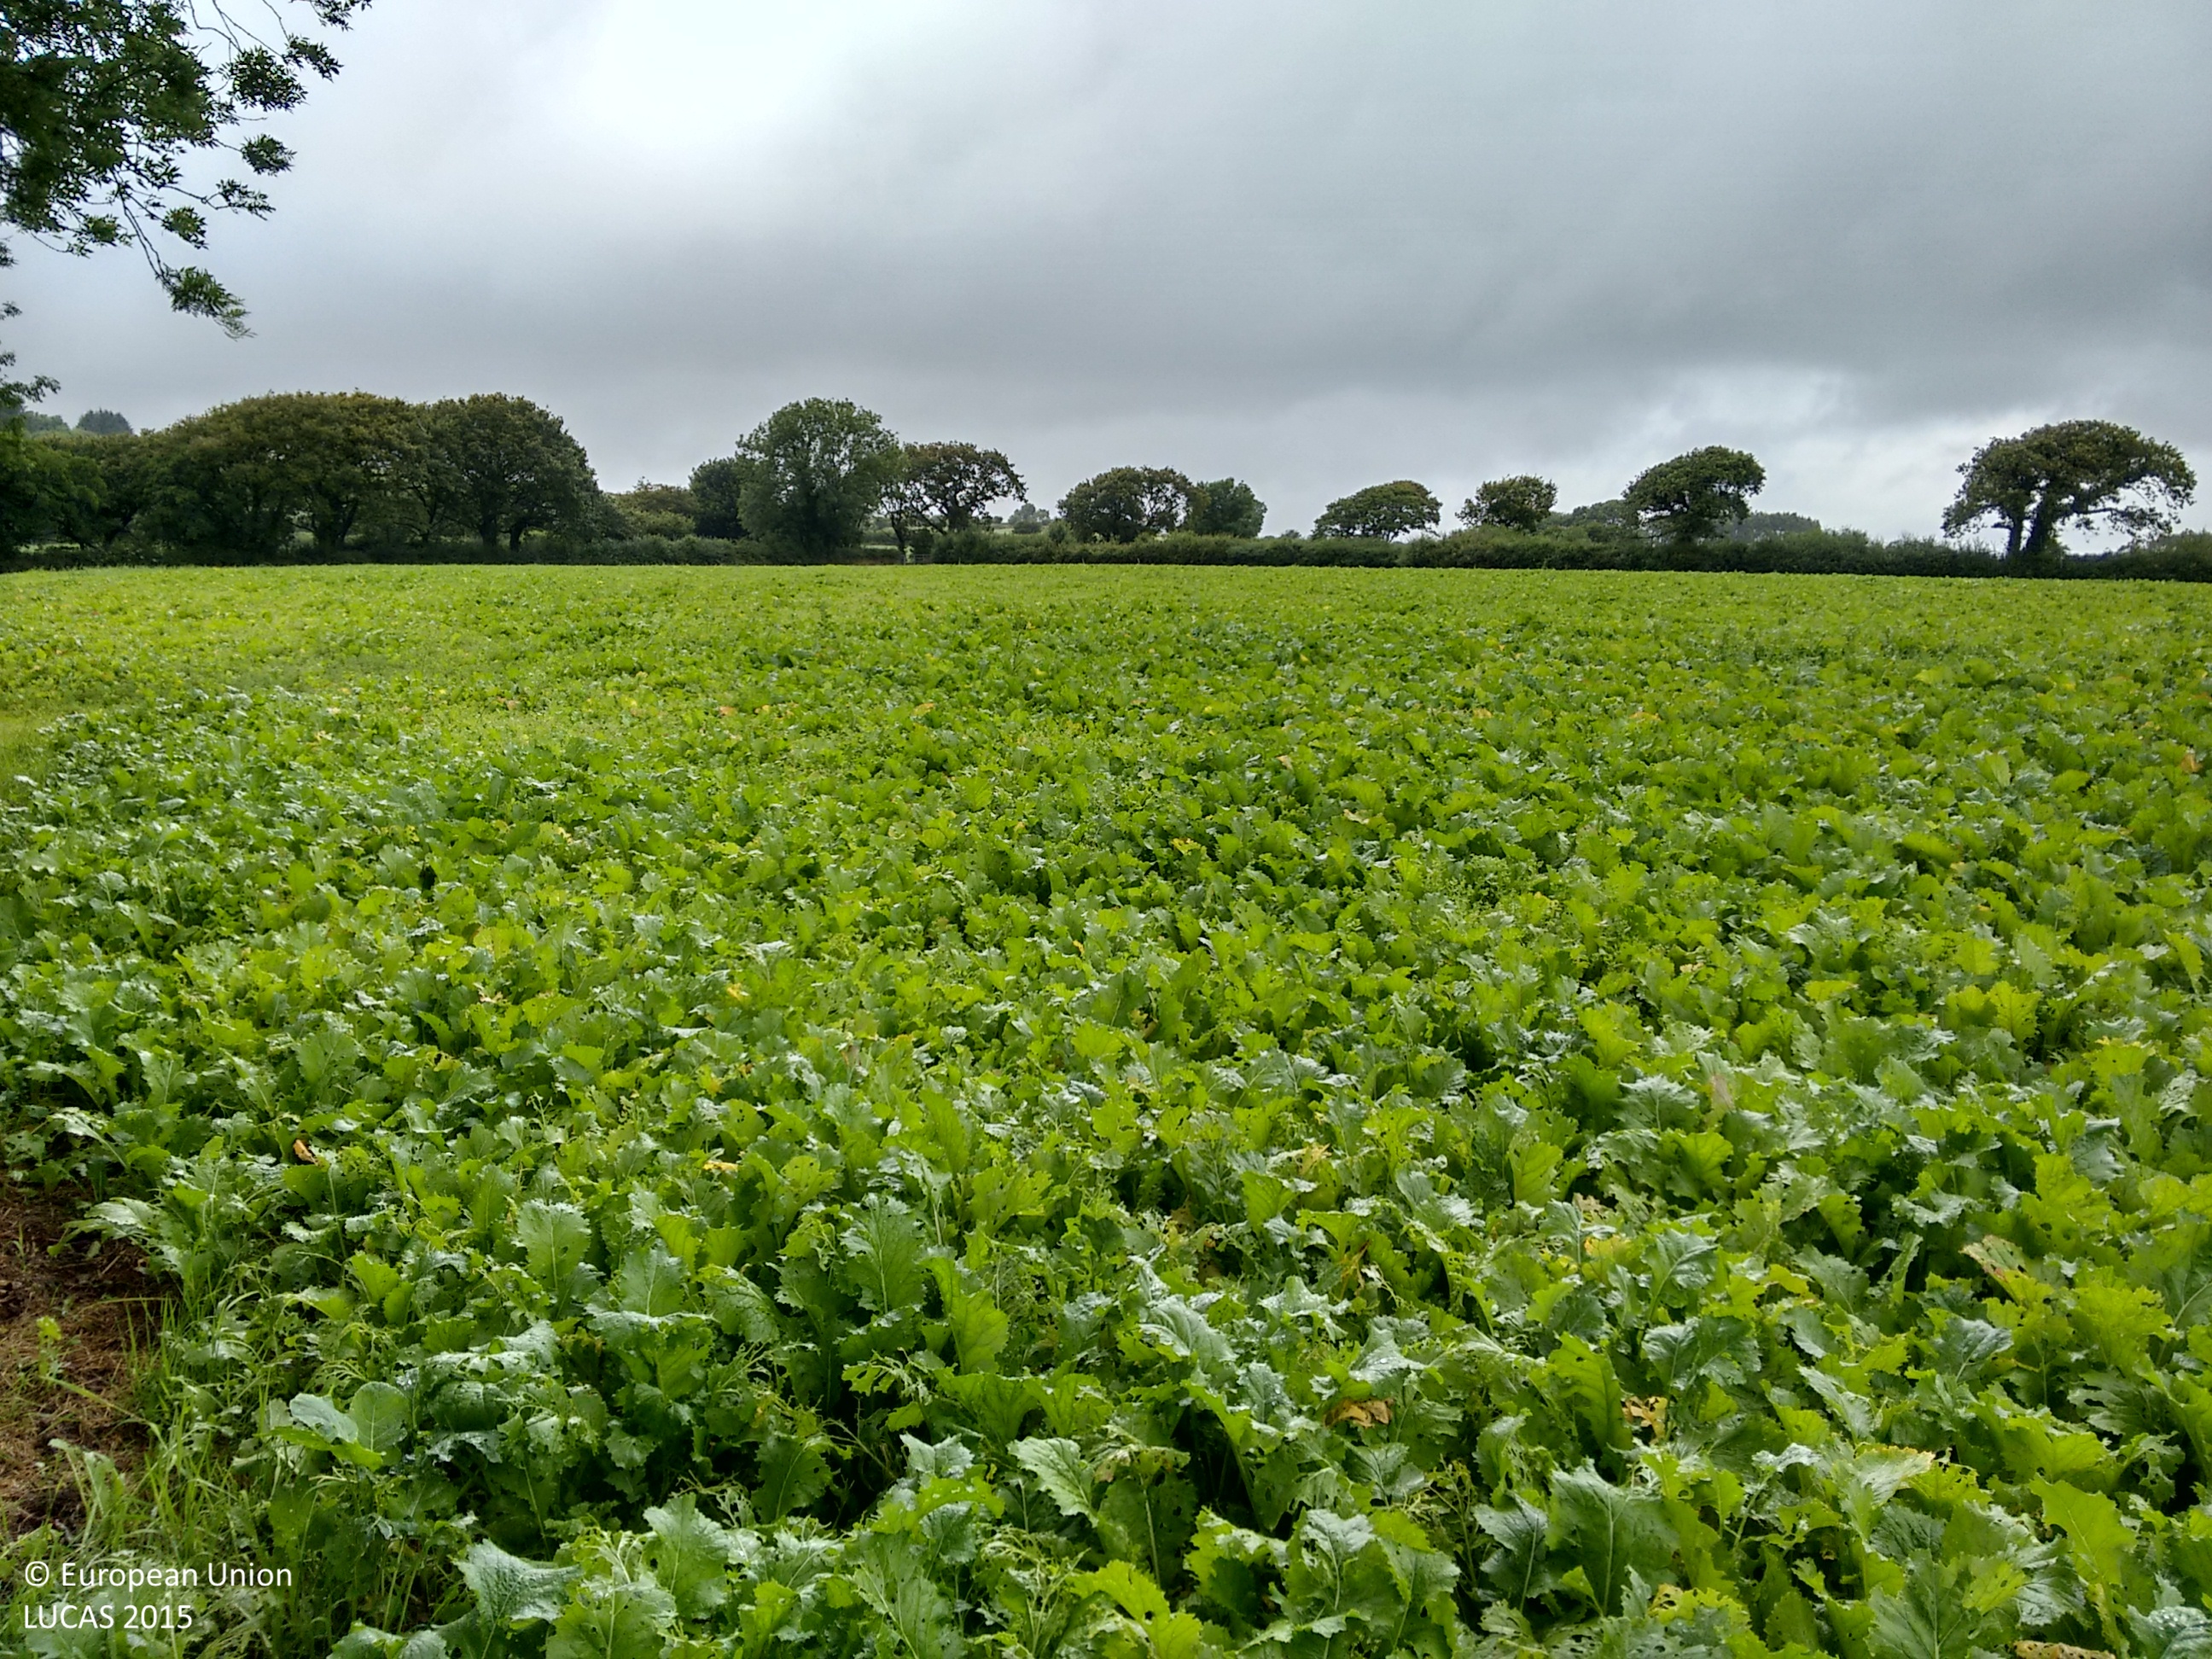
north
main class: Cropland
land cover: Other root crops
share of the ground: > 75 %
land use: Agriculture (excluding fallow land and kitchen gardens)
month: August
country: GB
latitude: 51.9421
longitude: -4.6114
